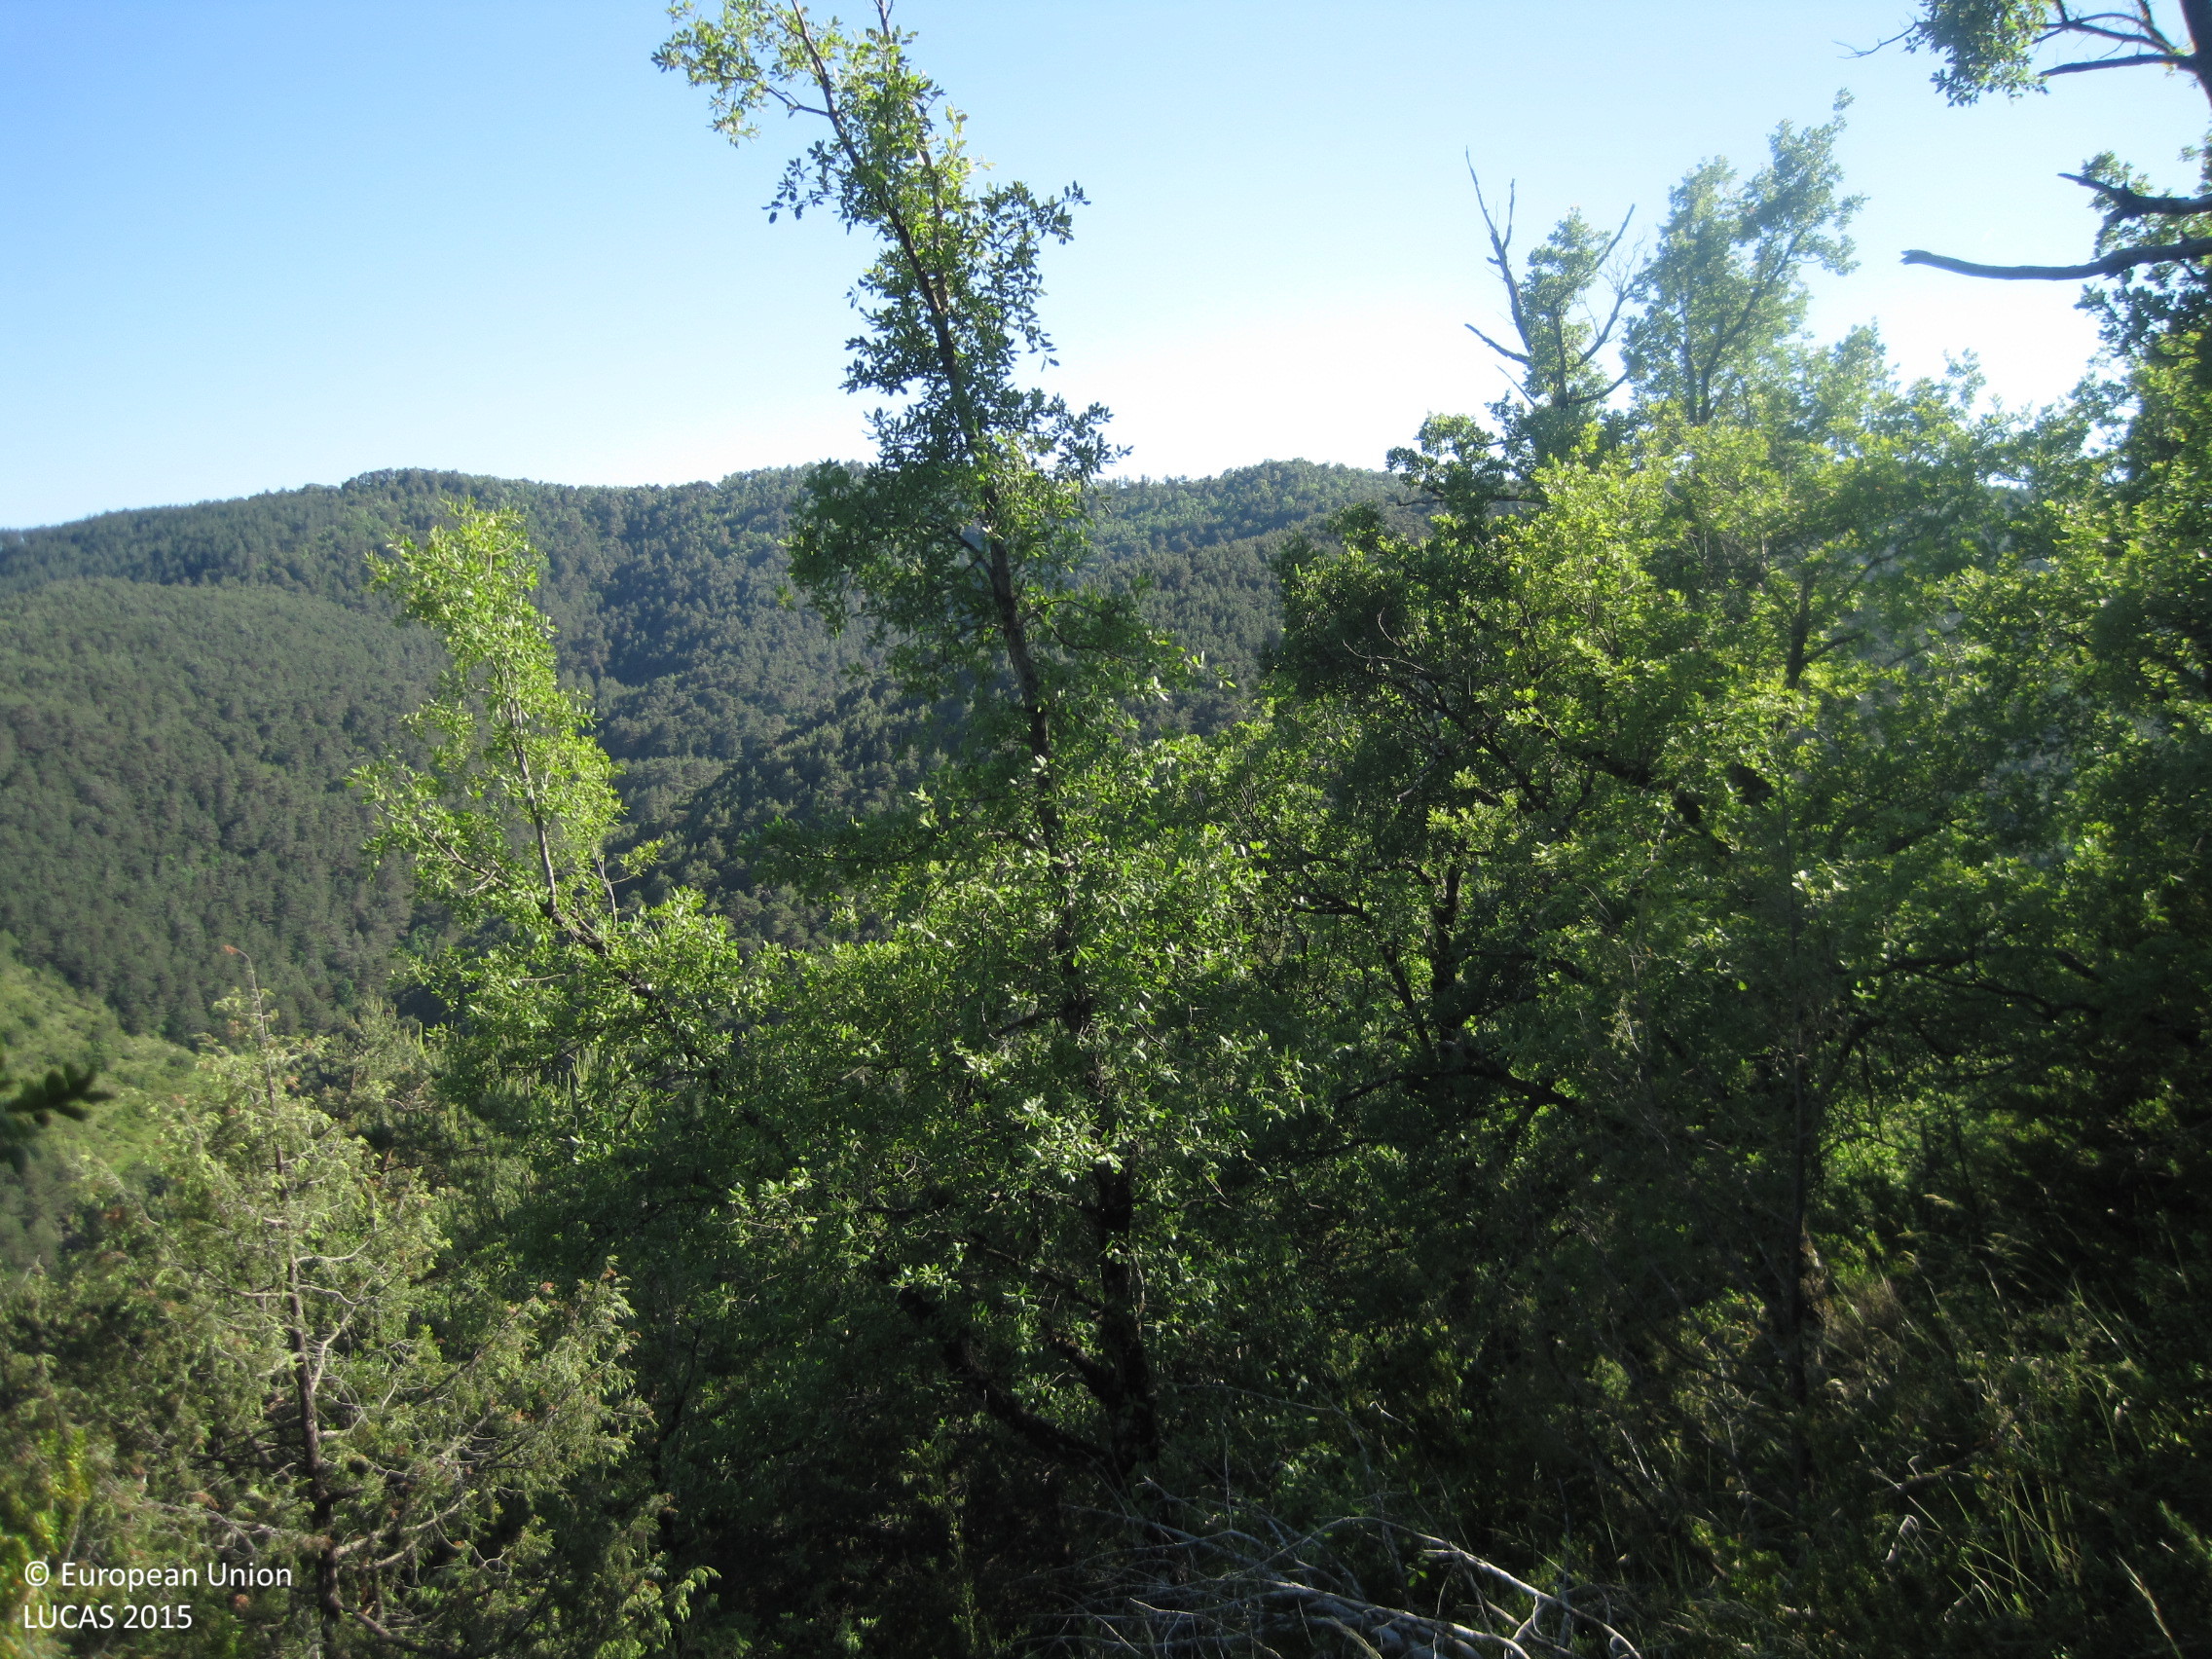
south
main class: Woodland
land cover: Broadleaved woodland
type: acidophilous oak and oak-birch forest
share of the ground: > 75 %
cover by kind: broadleaved forest trees 40 %, shrubs 40 %, herbaceous plants 20 %
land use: Semi-natural and natural areas not in use
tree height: > 5 m
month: May
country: ES
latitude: 42.8375
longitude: -1.4769
